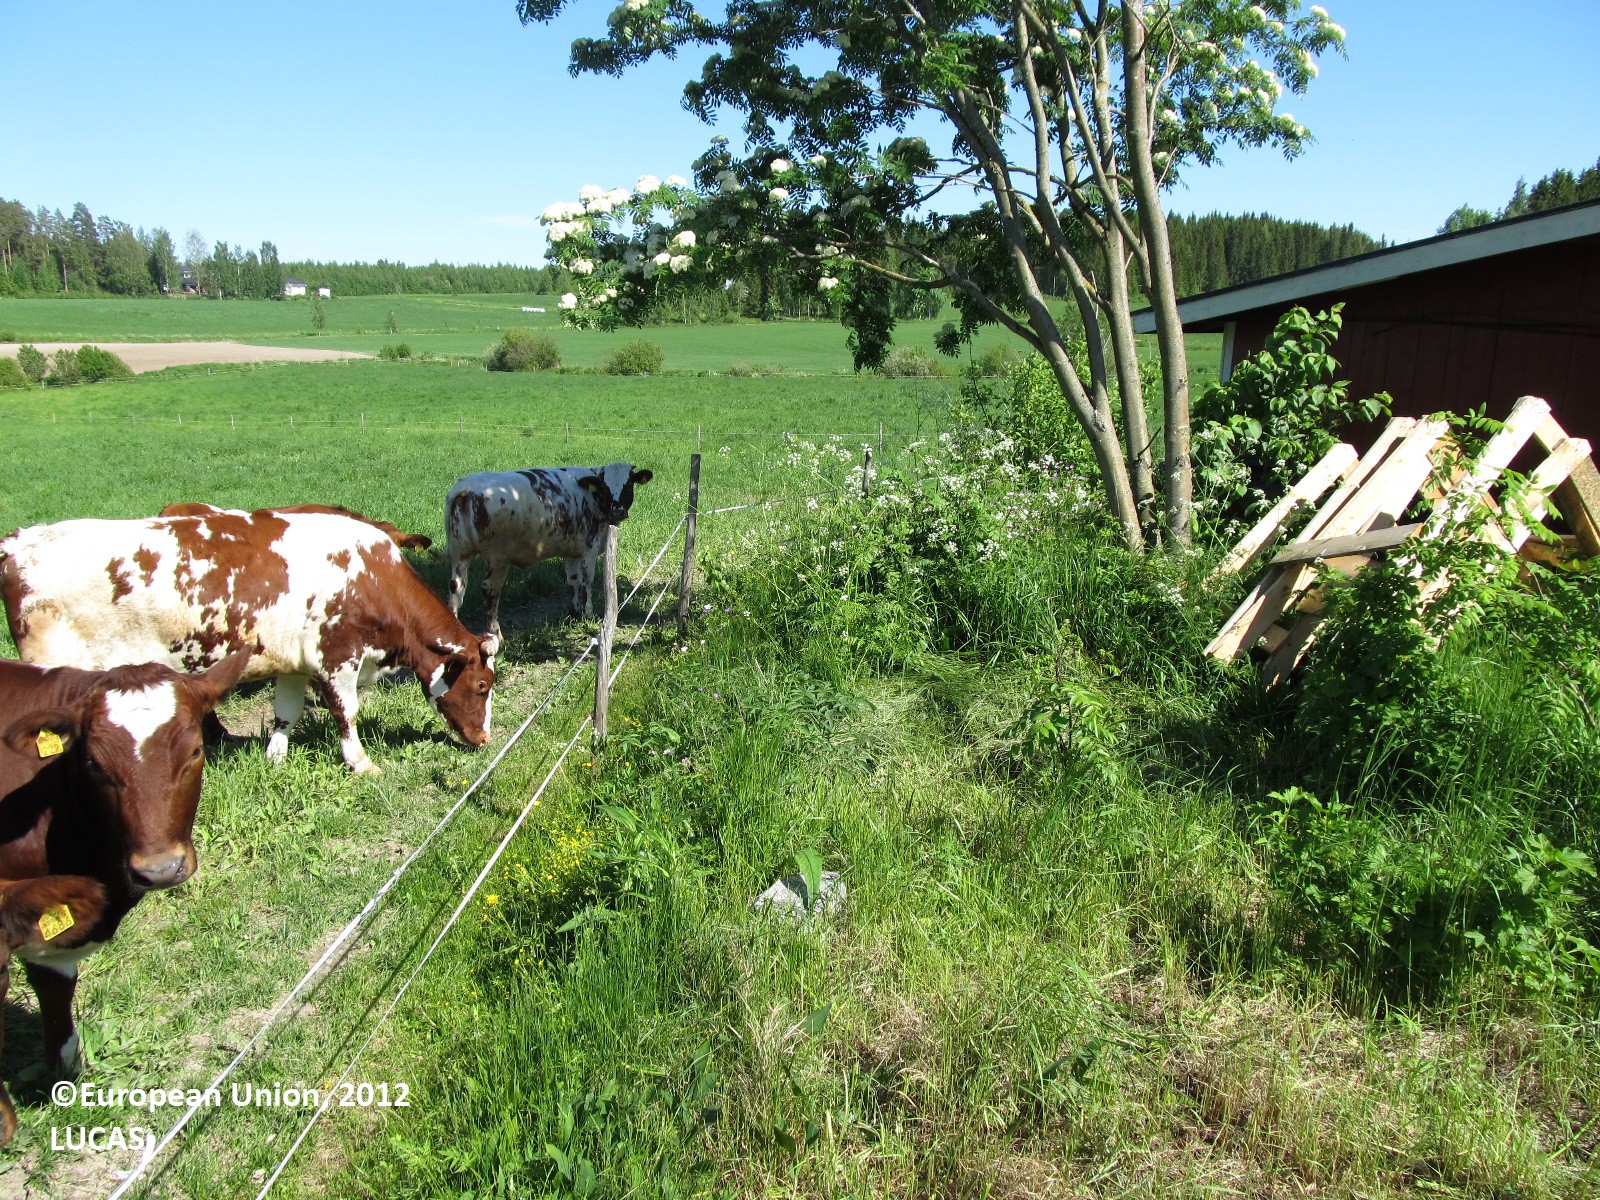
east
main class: Grassland
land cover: Grassland without tree/shrub cover
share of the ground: > 75 %
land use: Agriculture (excluding fallow land and kitchen gardens)
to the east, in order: Grassland without tree/shrub cover; Fences; Grassland without tree/shrub cover; Fences; Abandoned hedges; Rivers and streams; Single bushes/trees; Barley
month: June
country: FI
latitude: 63.0323
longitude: 27.5772
